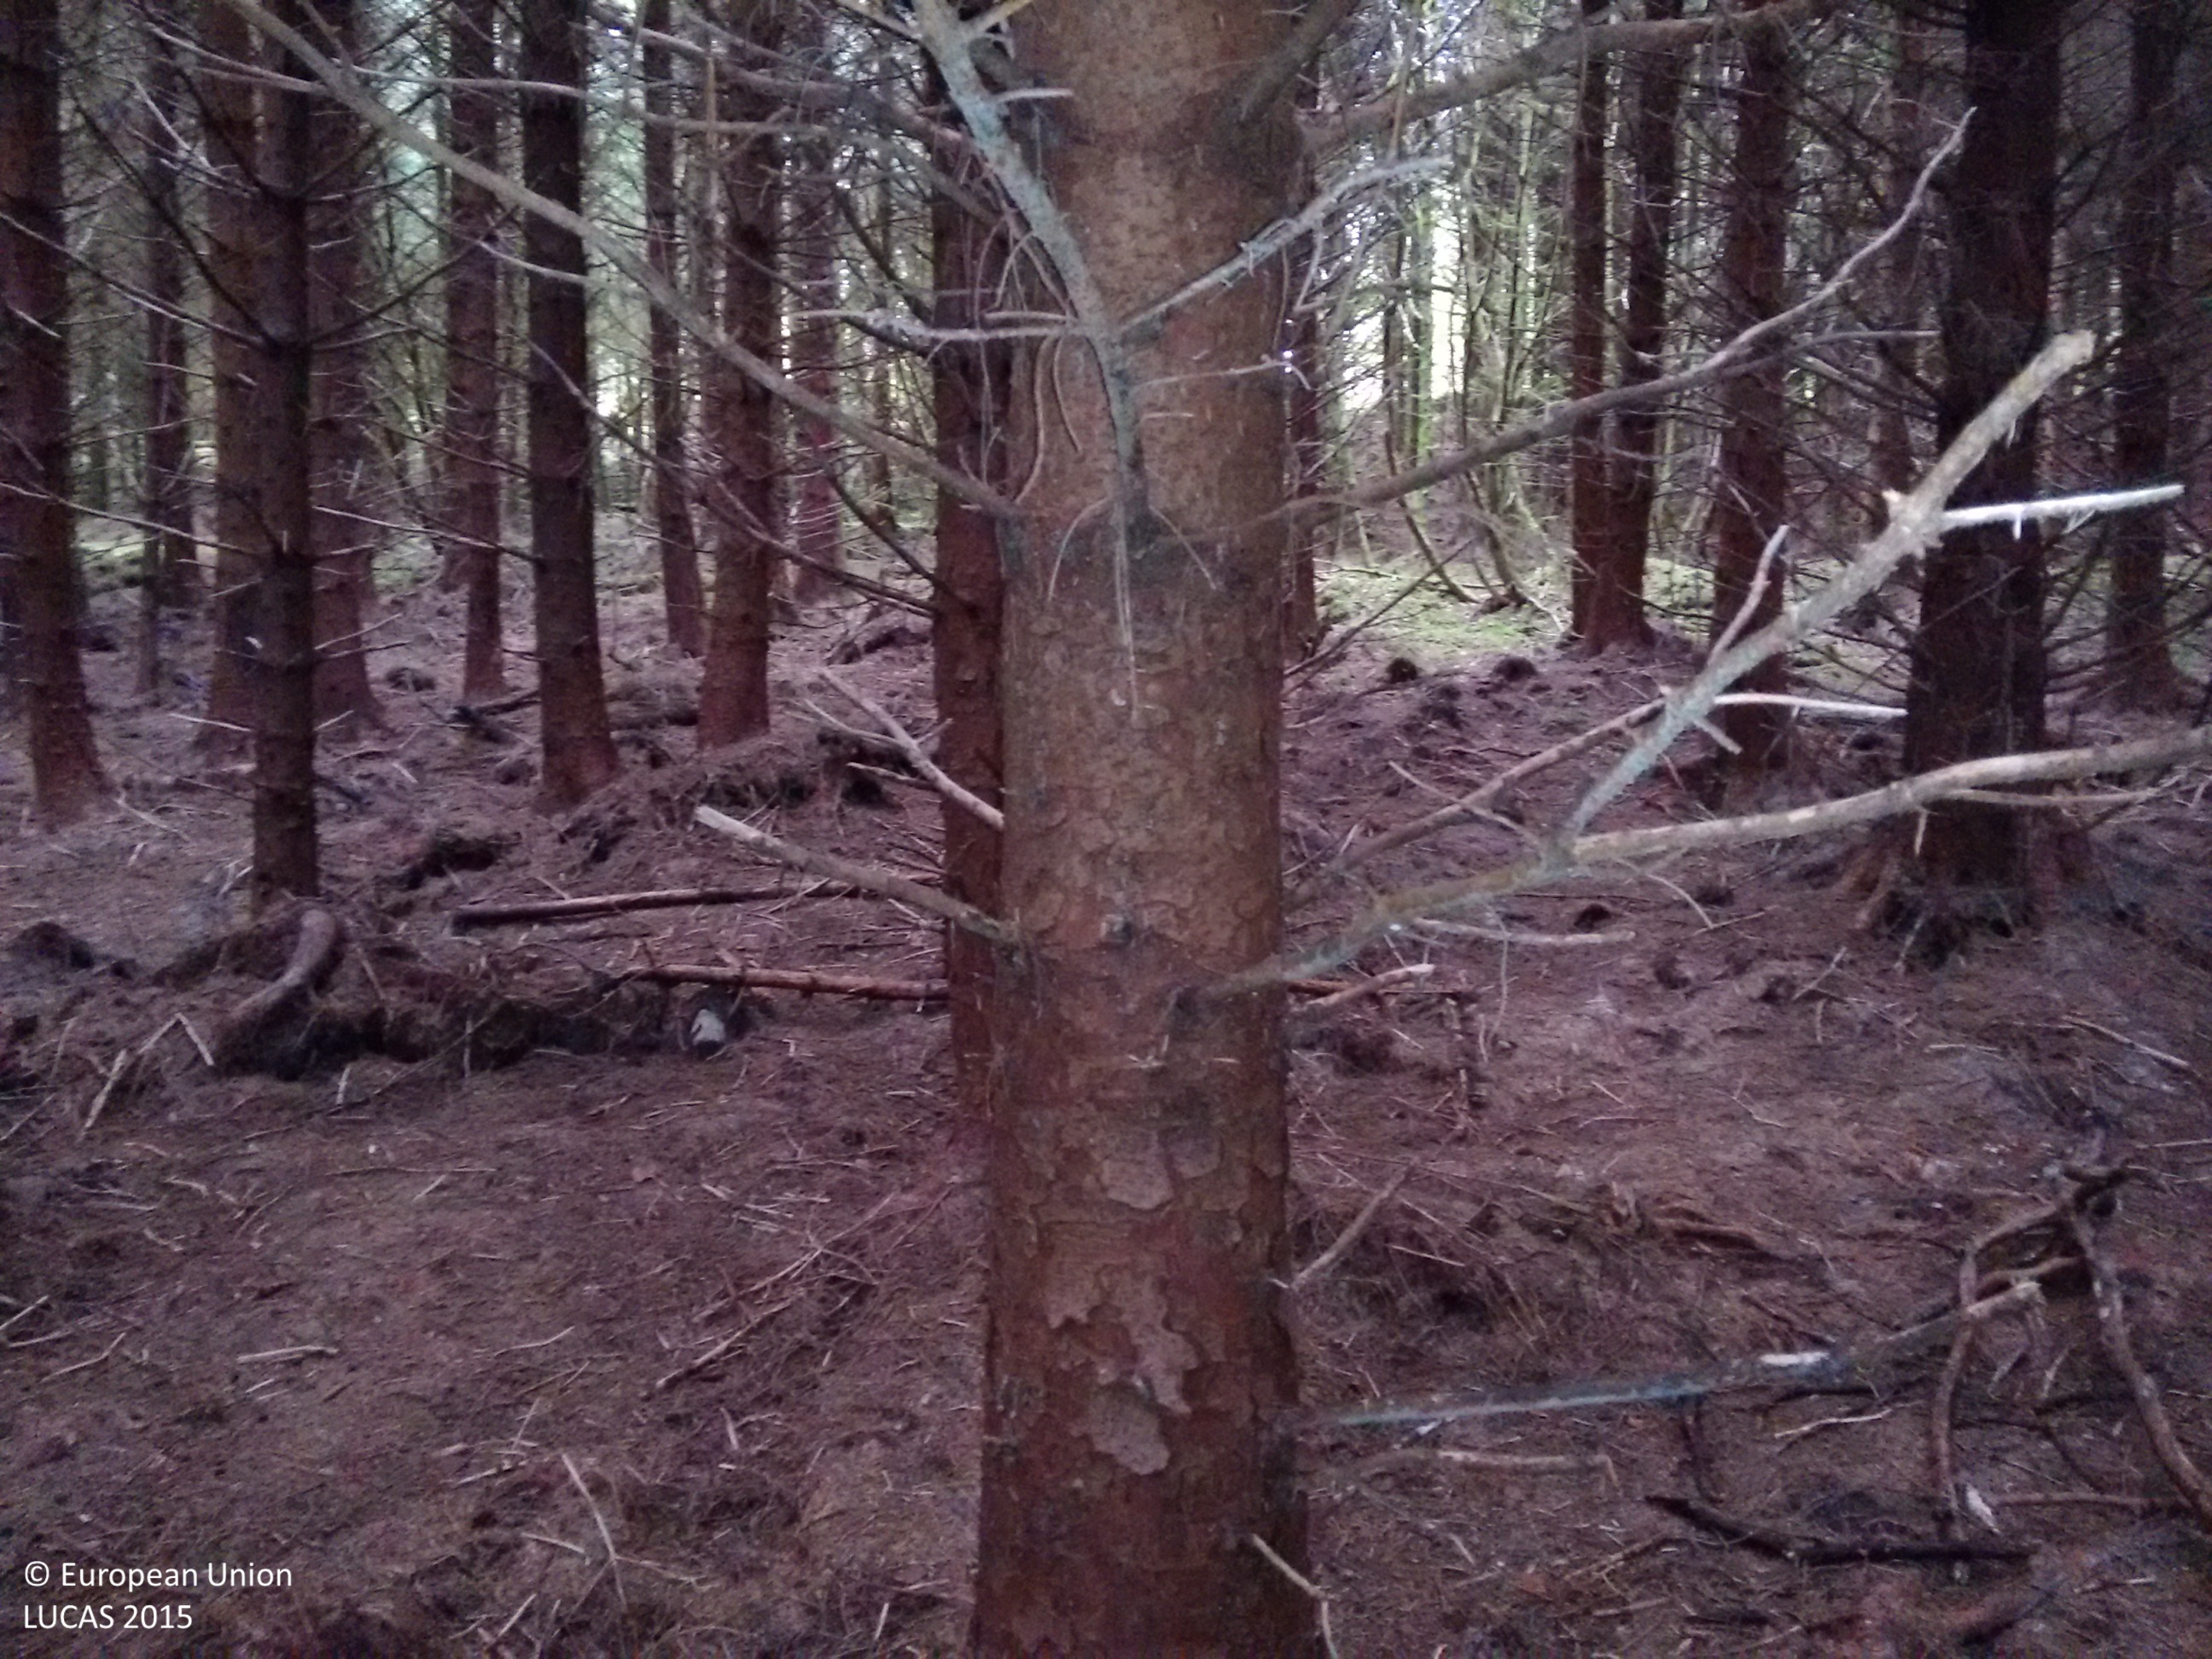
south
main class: Woodland
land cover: Spruce dominated coniferous woodland
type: exotic forest
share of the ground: > 75 %
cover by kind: coniferous forest trees 100 %
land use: Forestry
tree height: > 5 m
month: October
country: GB
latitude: 54.5217
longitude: -7.9217
